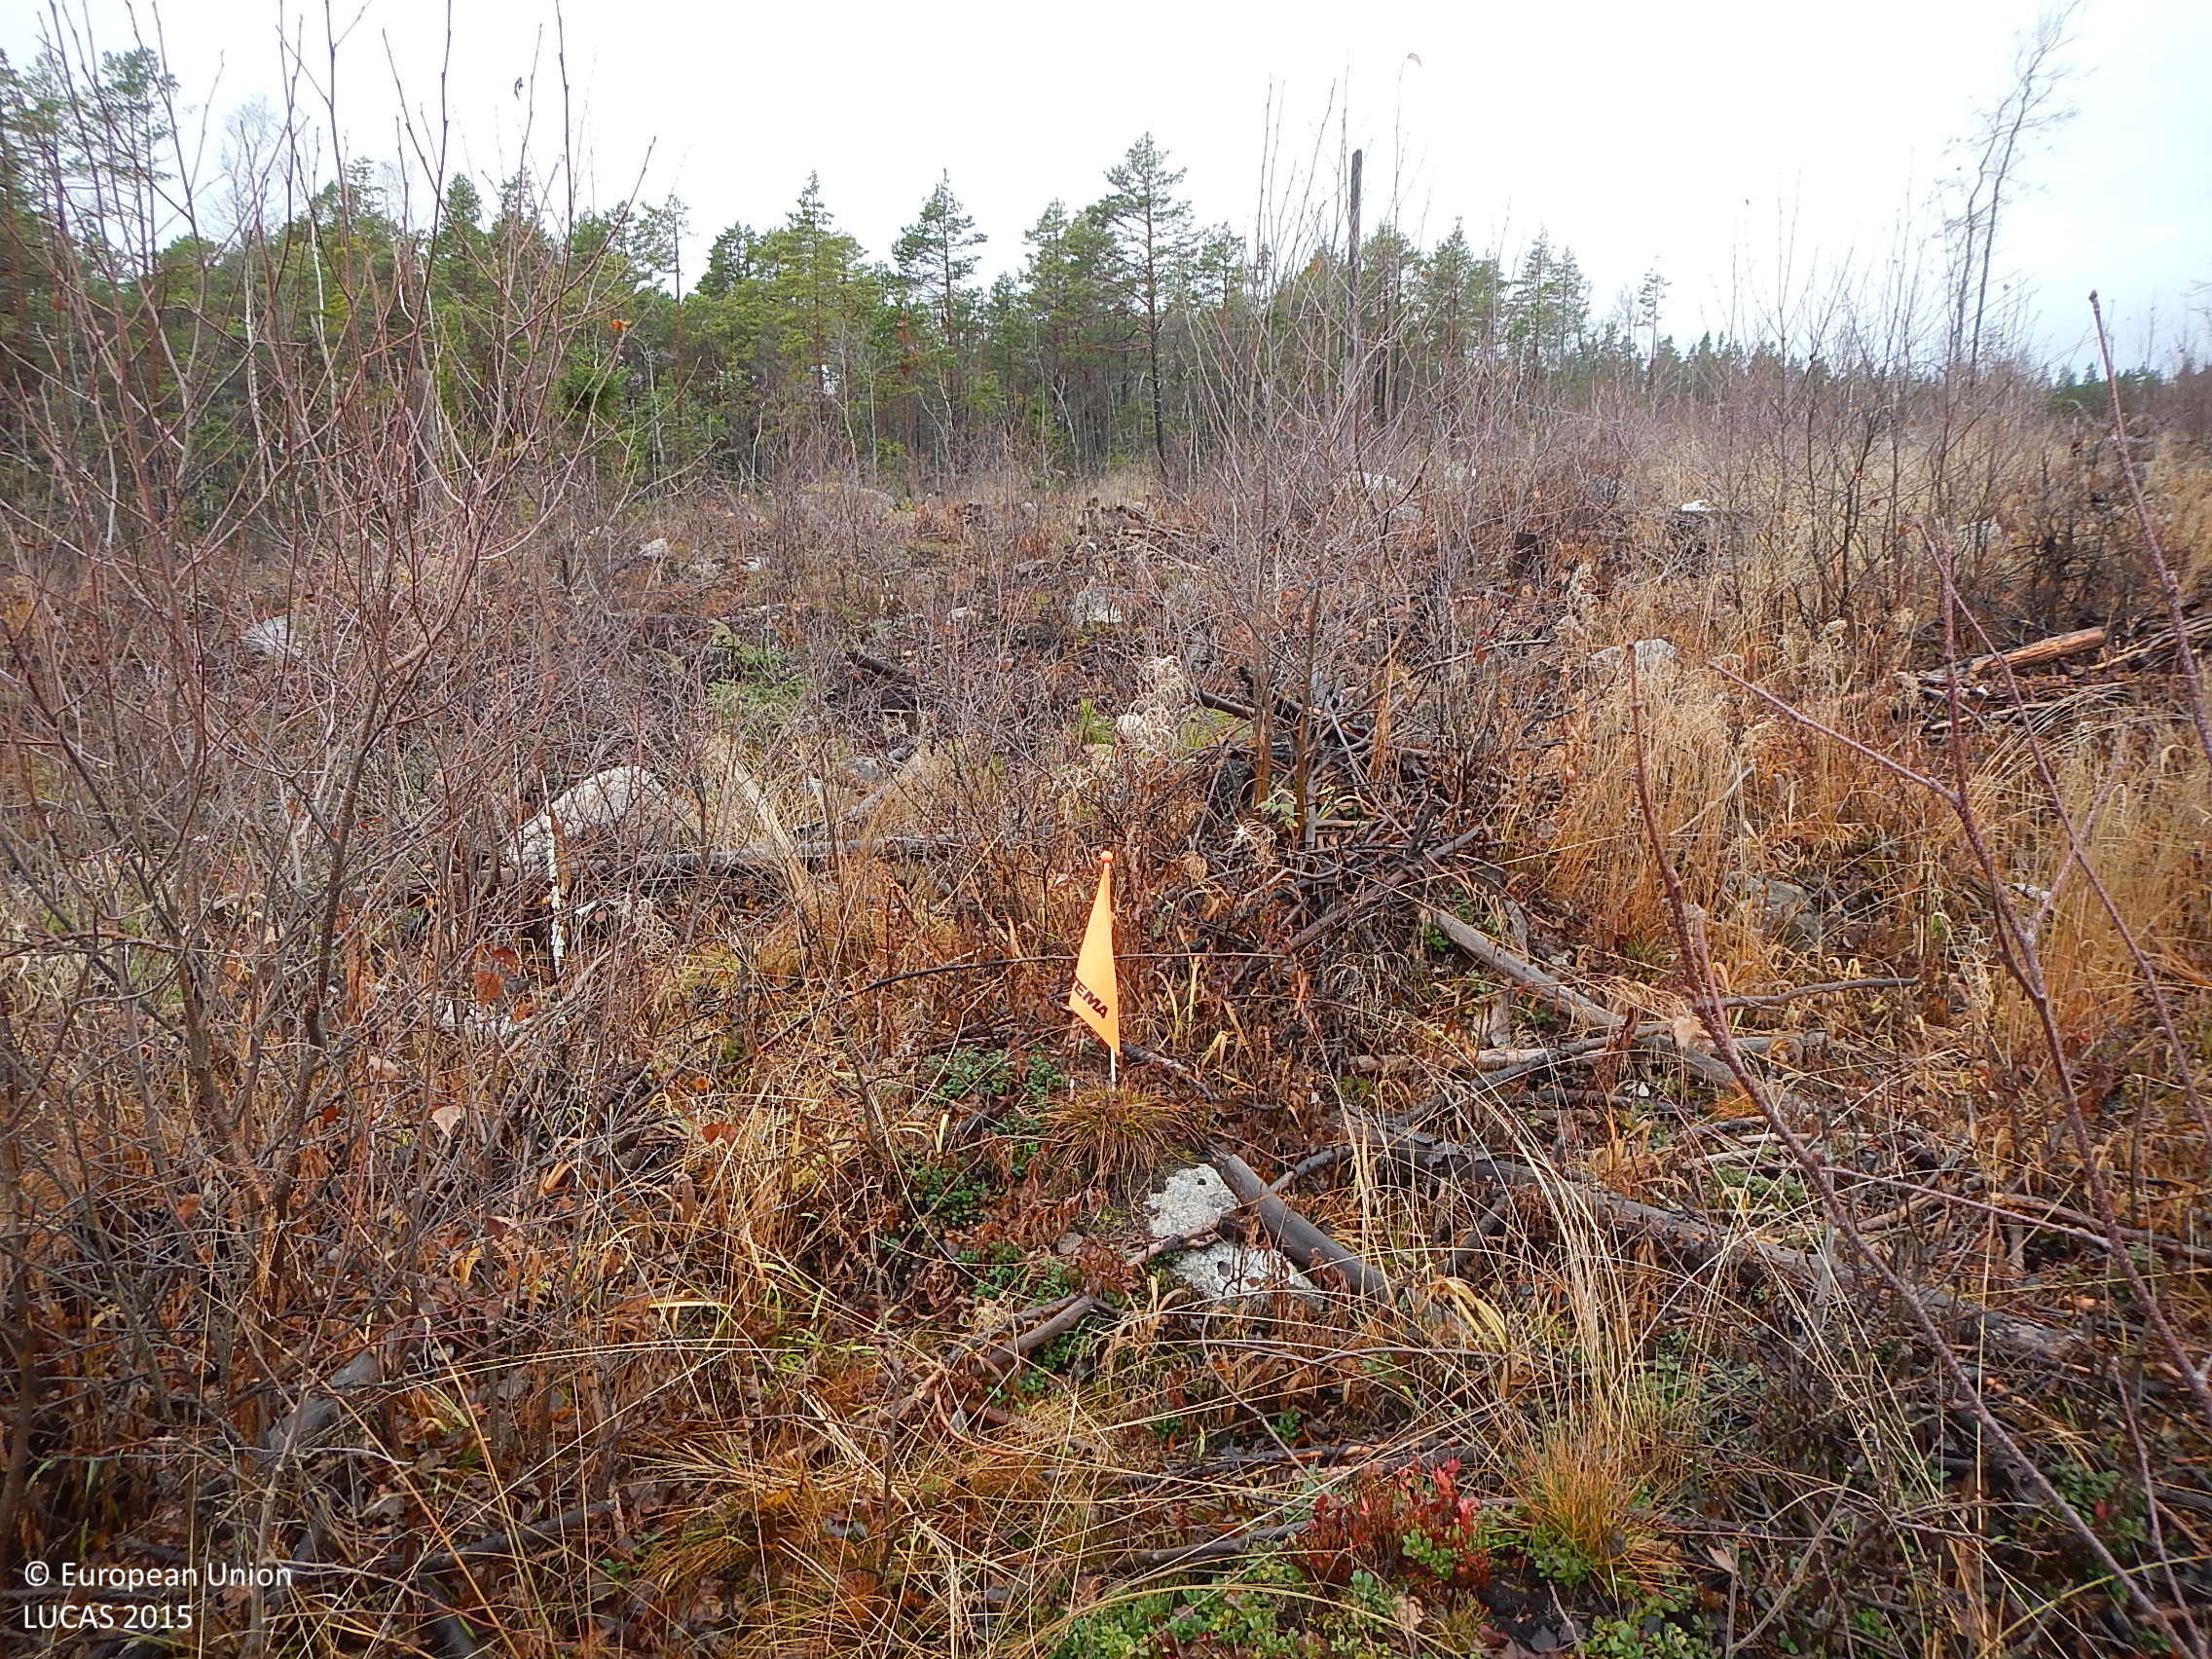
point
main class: Woodland
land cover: Broadleaved woodland
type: boreal forest
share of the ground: 10 - 25 %
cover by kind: shrubs 40 %, herbaceous plants 30 %, broadleaved forest trees 20 %, consolidated bare surface 5 %, unconsolidated bare surface 5 %
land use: Forestry
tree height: < 5 m
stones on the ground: 10 - 25 %
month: November
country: SE
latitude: 60.9927
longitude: 17.1789
